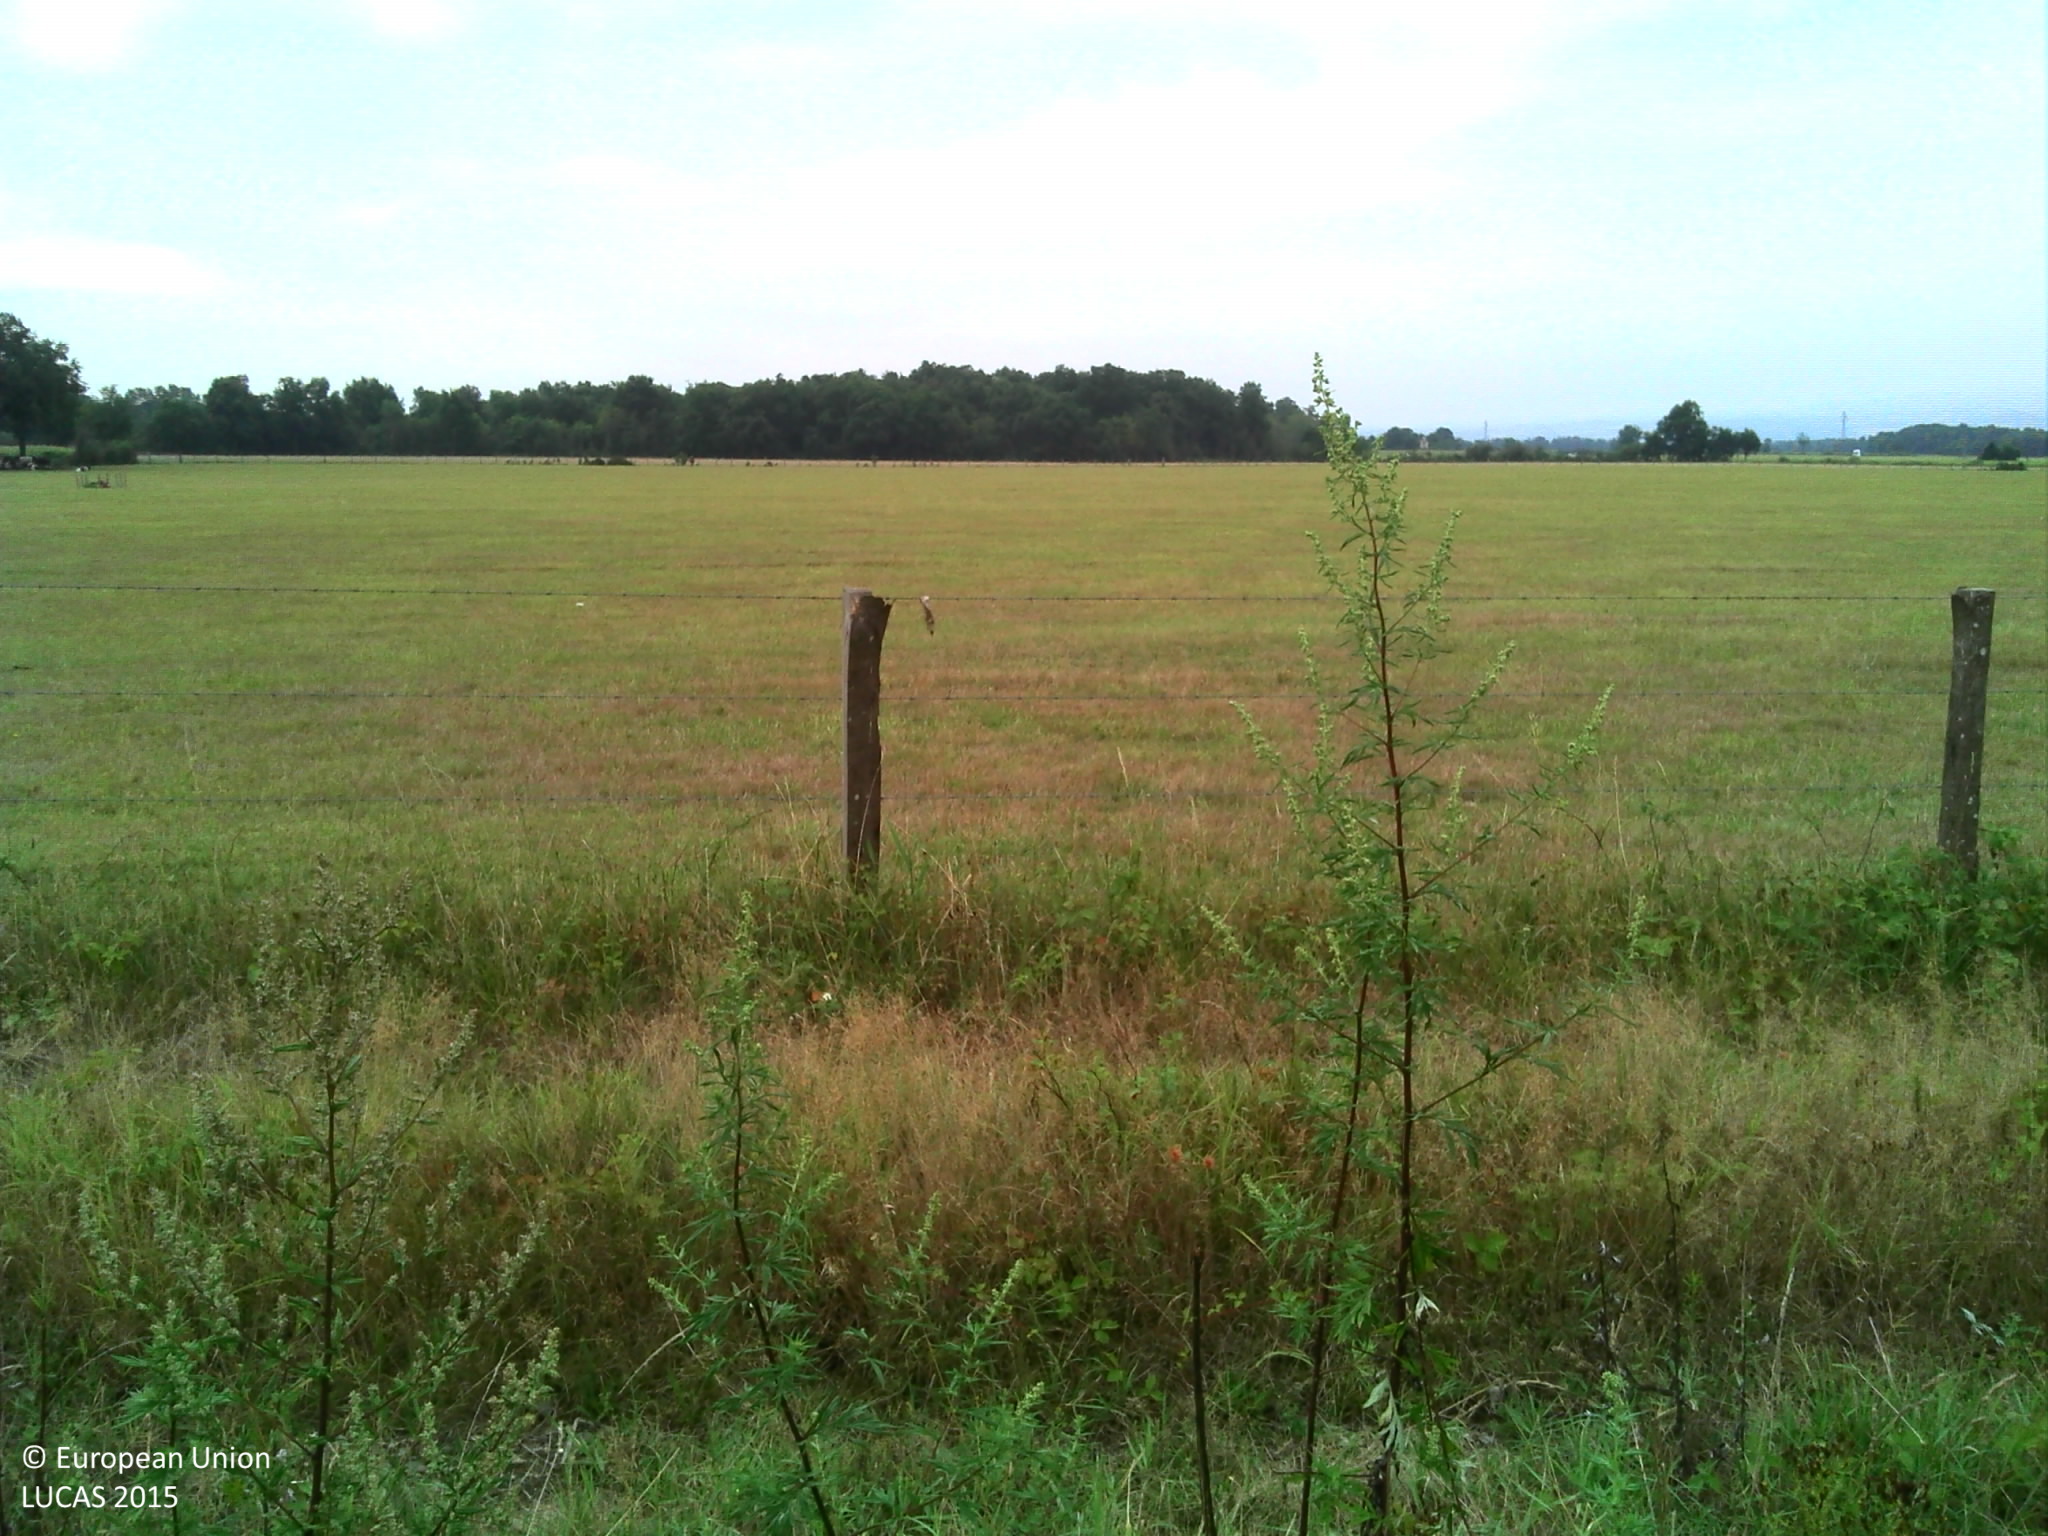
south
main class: Cropland
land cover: Maize
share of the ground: 50 - 75 %
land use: Agriculture (excluding fallow land and kitchen gardens)
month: August
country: FR
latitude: 45.6307
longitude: 4.1408
